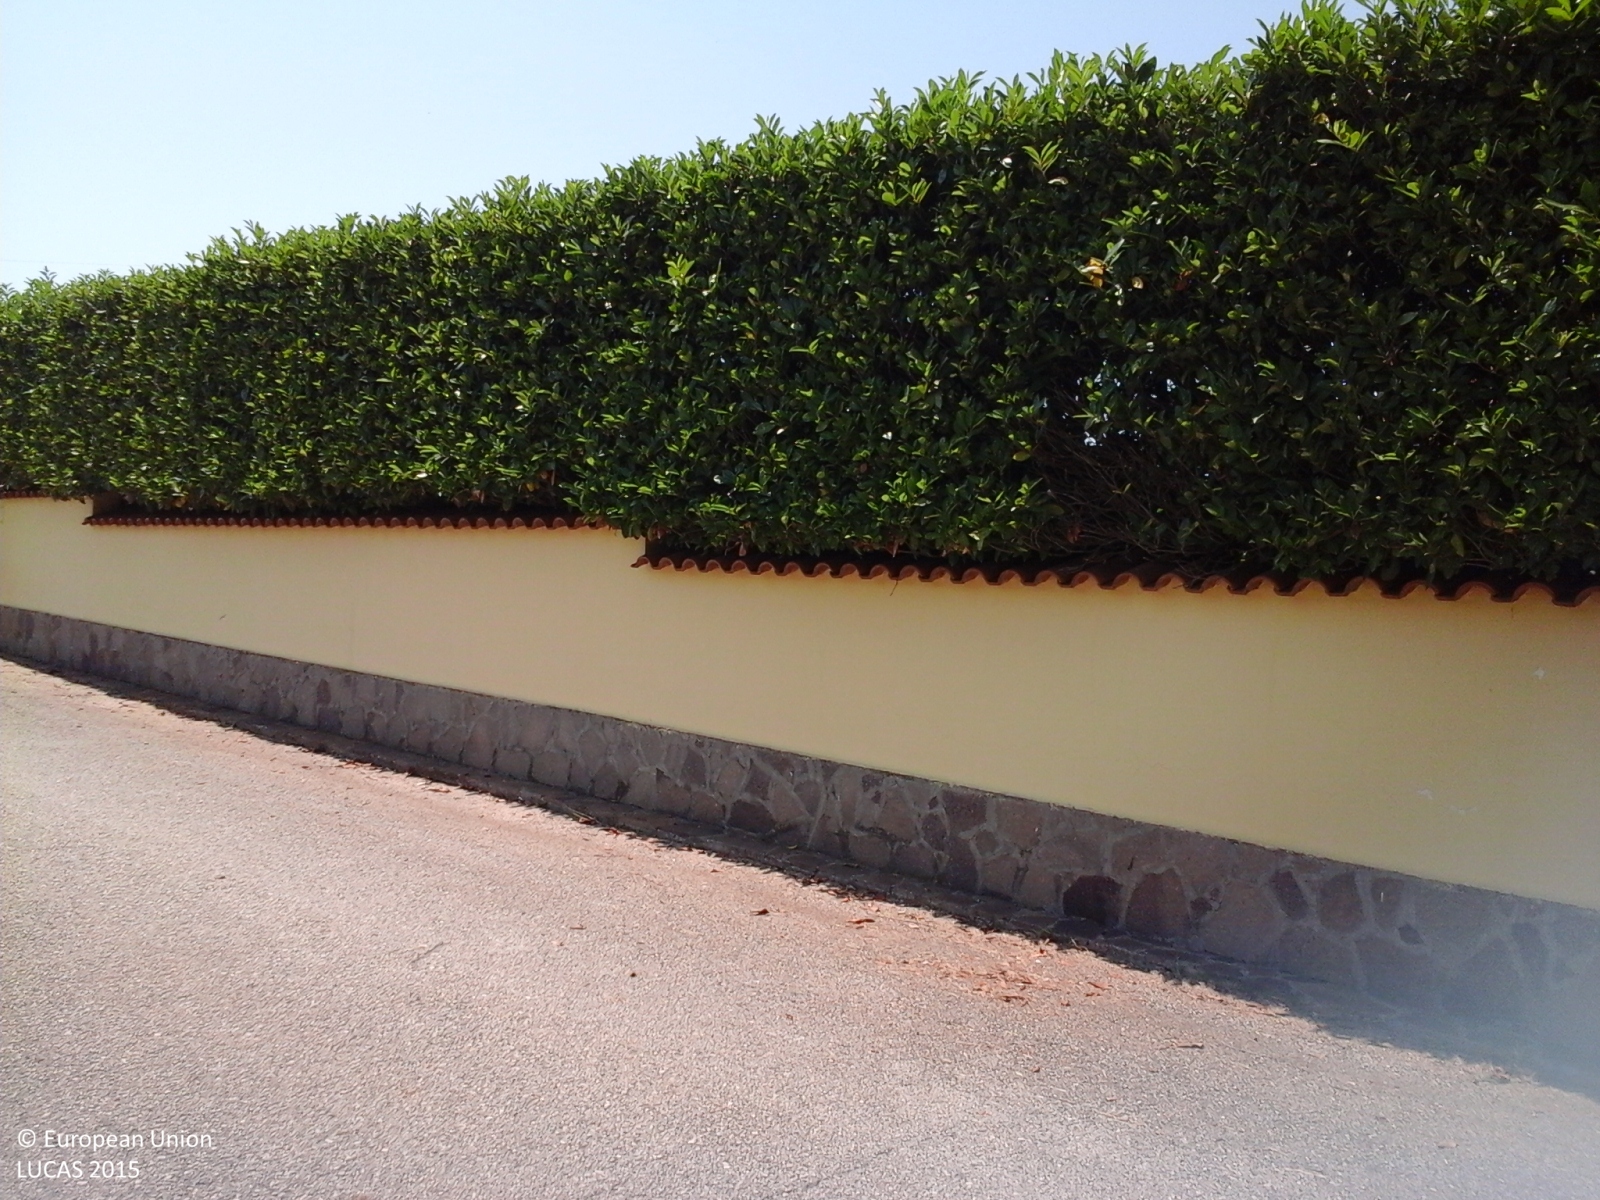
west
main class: Cropland
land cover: Other fruit trees and berries
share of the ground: > 75 %
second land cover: Grassland without tree/shrub cover
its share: > 75 %
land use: Agriculture (excluding fallow land and kitchen gardens)
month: July
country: IT
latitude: 41.6027
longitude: 12.8087
